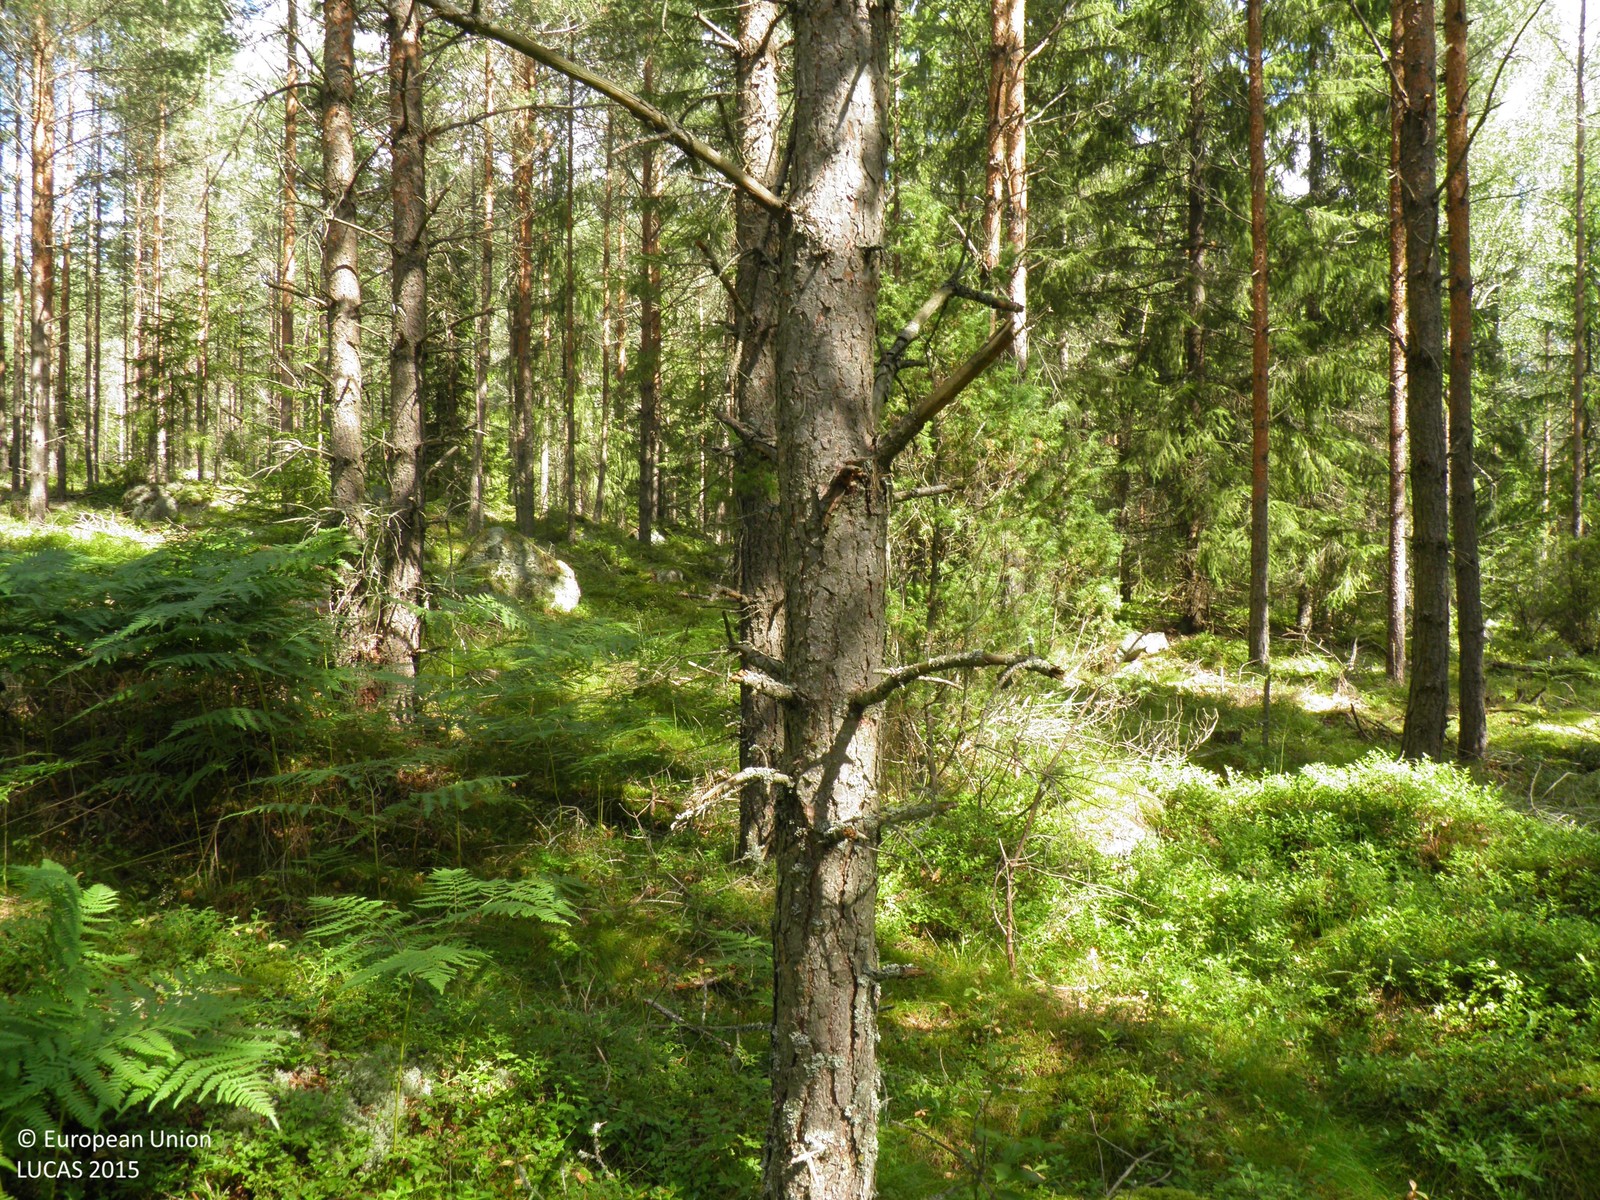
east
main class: Woodland
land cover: Pine dominated coniferous woodland
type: hemiboreal forest and nemoral coniferous forest and mixed broadleaved-coniferous forest
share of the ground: 50 - 75 %
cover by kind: coniferous forest trees 60 %, shrubs 15 %, herbaceous plants 10 %, lichens and mosses 10 %, broadleaved forest trees 5 %
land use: Forestry
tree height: > 5 m
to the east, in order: Pine dominated coniferous woodland; Spruce dominated mixed woodland; Broadleaved woodland
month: August
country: FI
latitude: 60.9800
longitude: 22.8414
